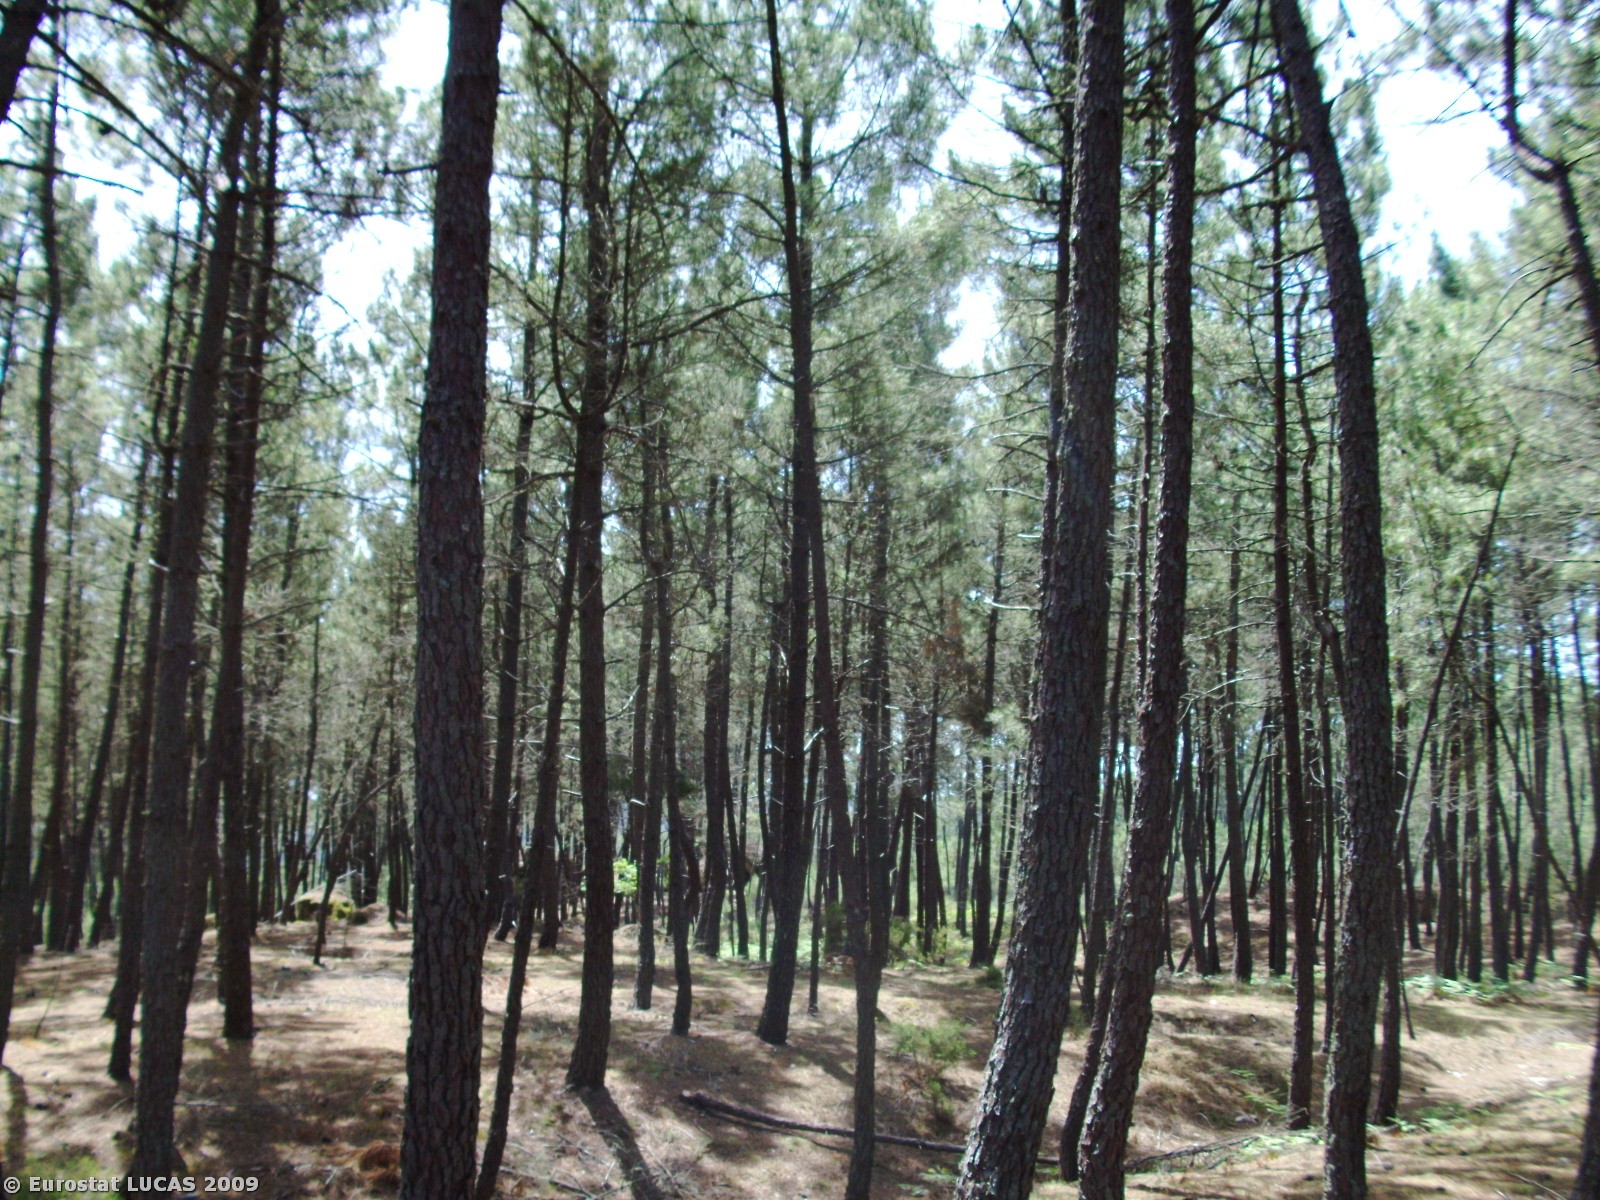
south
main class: Woodland
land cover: Coniferous woodland
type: coniferous forest of the mediterranean region
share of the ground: > 75 %
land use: Forestry
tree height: > 5 m
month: July
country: PT
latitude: 40.8079
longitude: -7.6767
